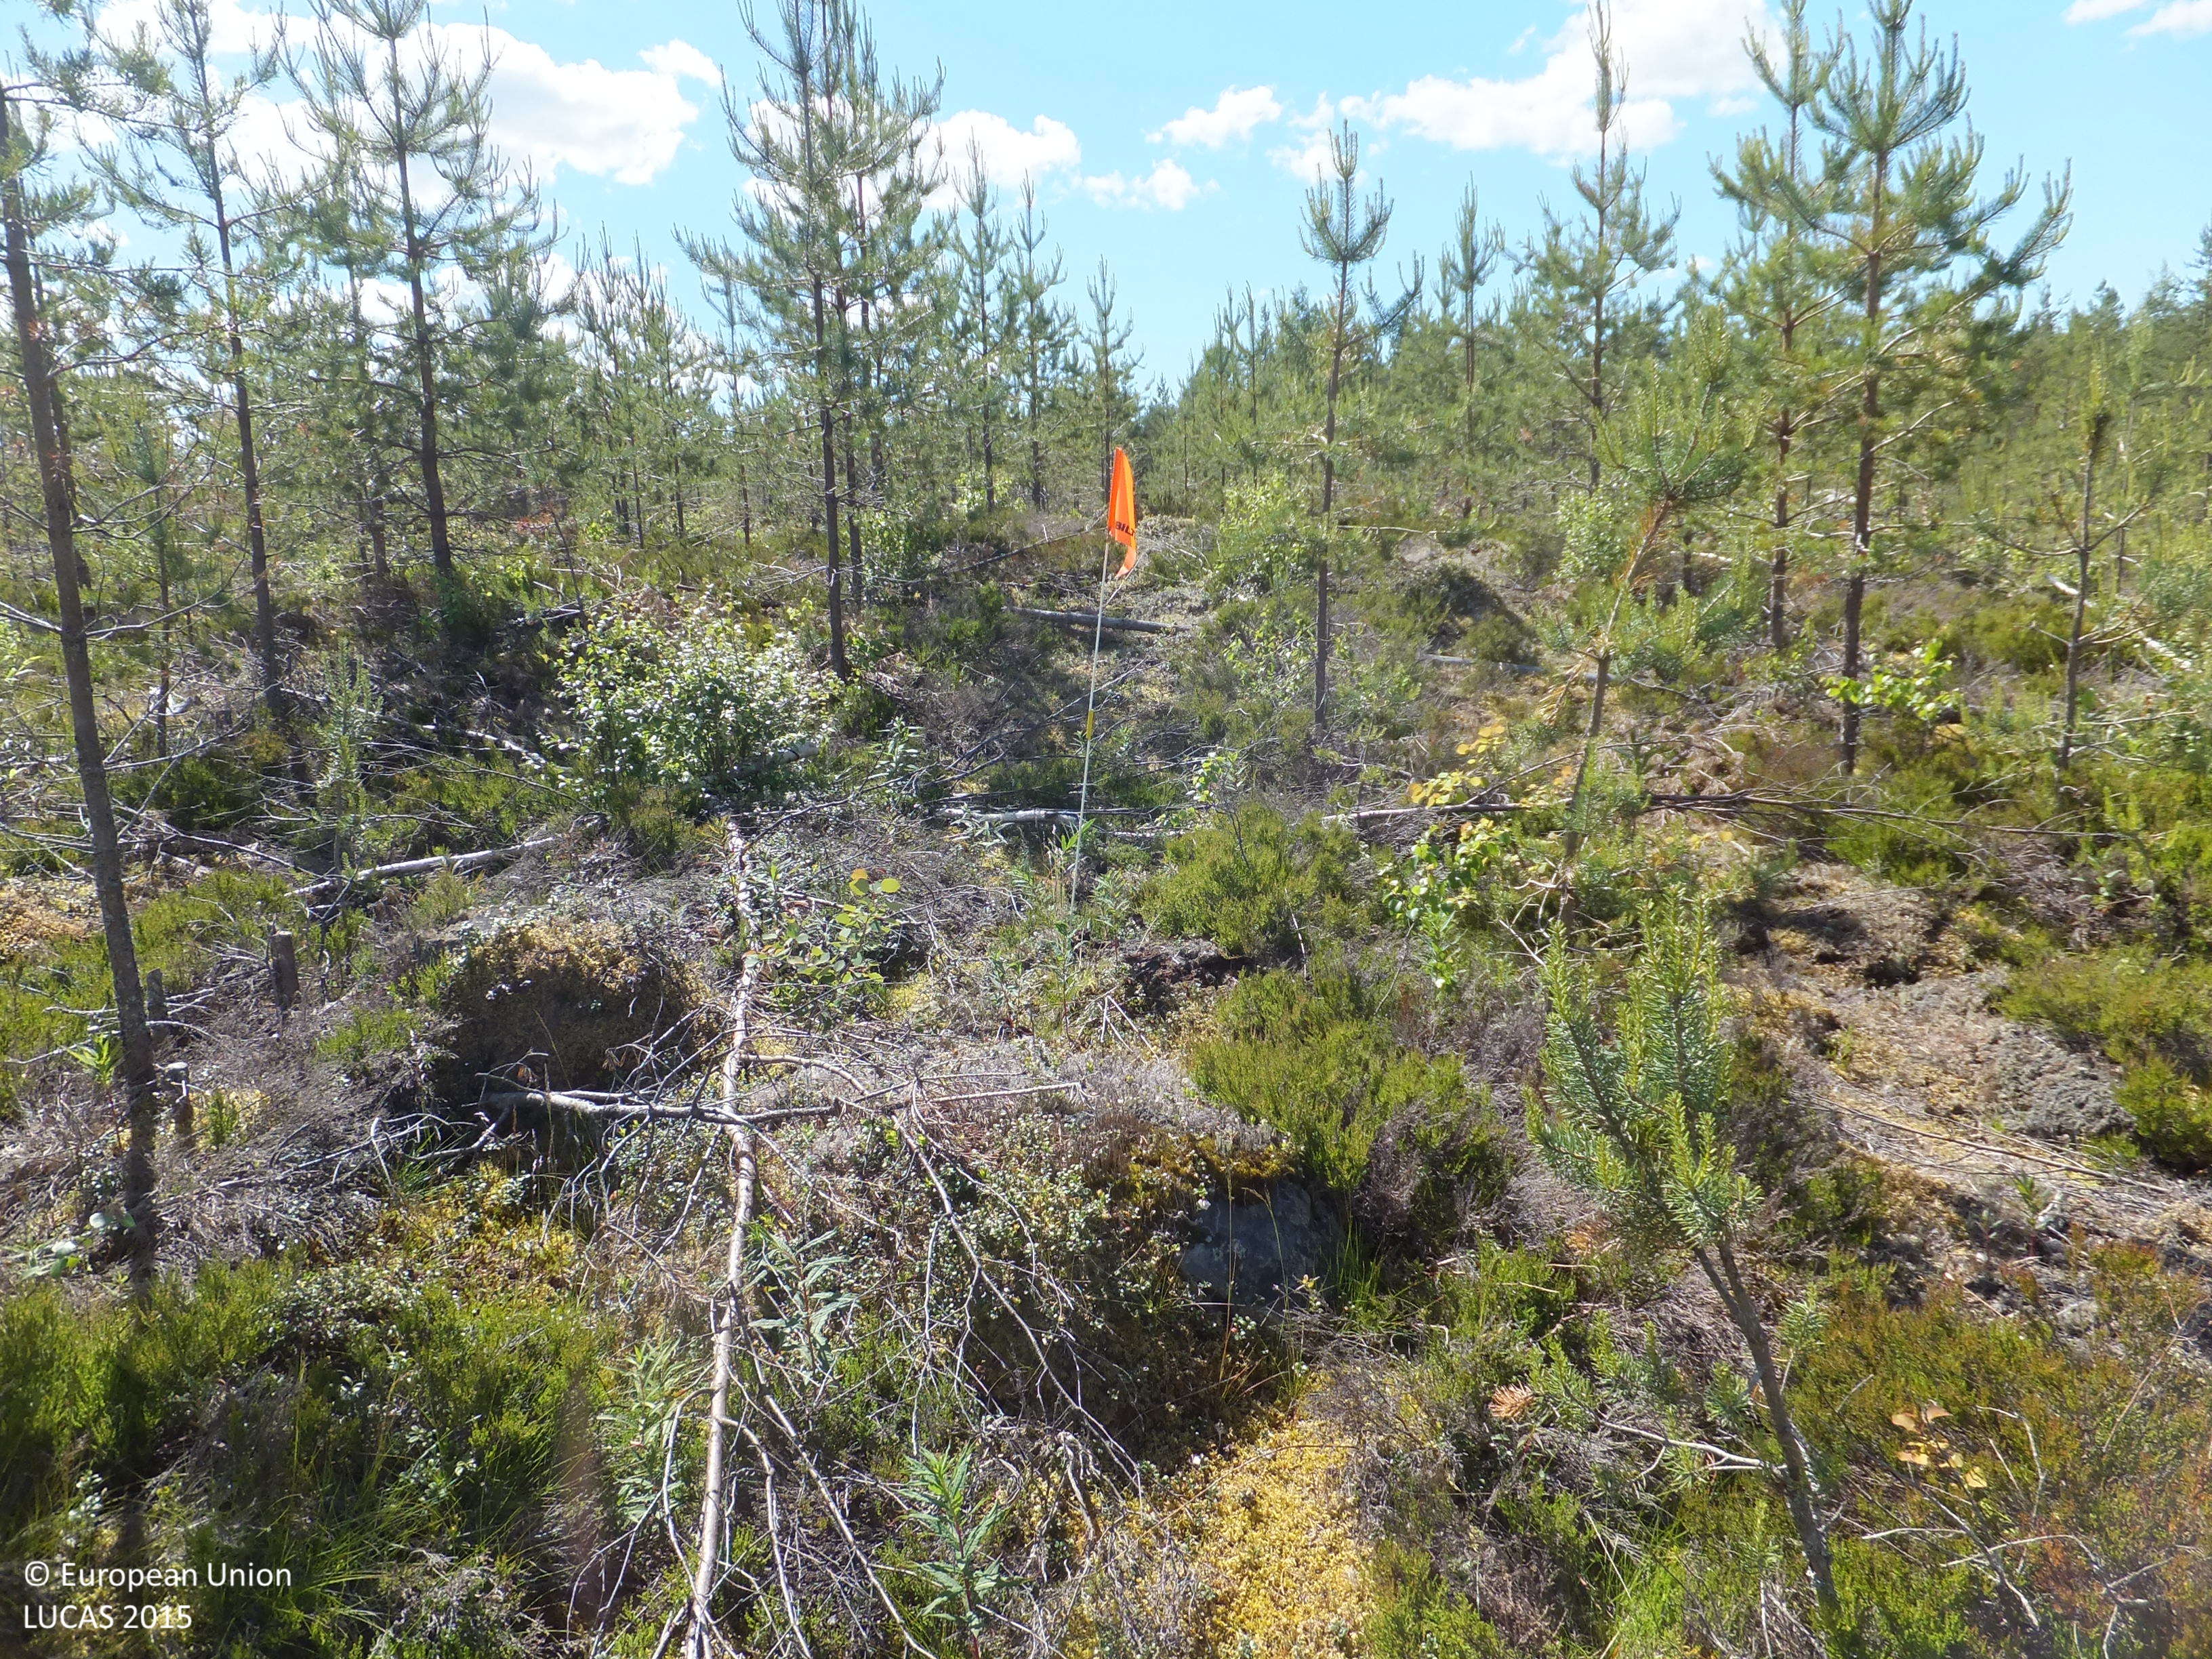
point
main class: Woodland
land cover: Pine dominated mixed woodland
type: boreal forest
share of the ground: 25 - 50 %
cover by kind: shrubs 35 %, coniferous forest trees 25 %, lichens and mosses 20 %, broadleaved forest trees 15 %, herbaceous plants 5 %
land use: Forestry
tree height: < 5 m
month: July
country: FI
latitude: 63.0120
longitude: 24.0807
